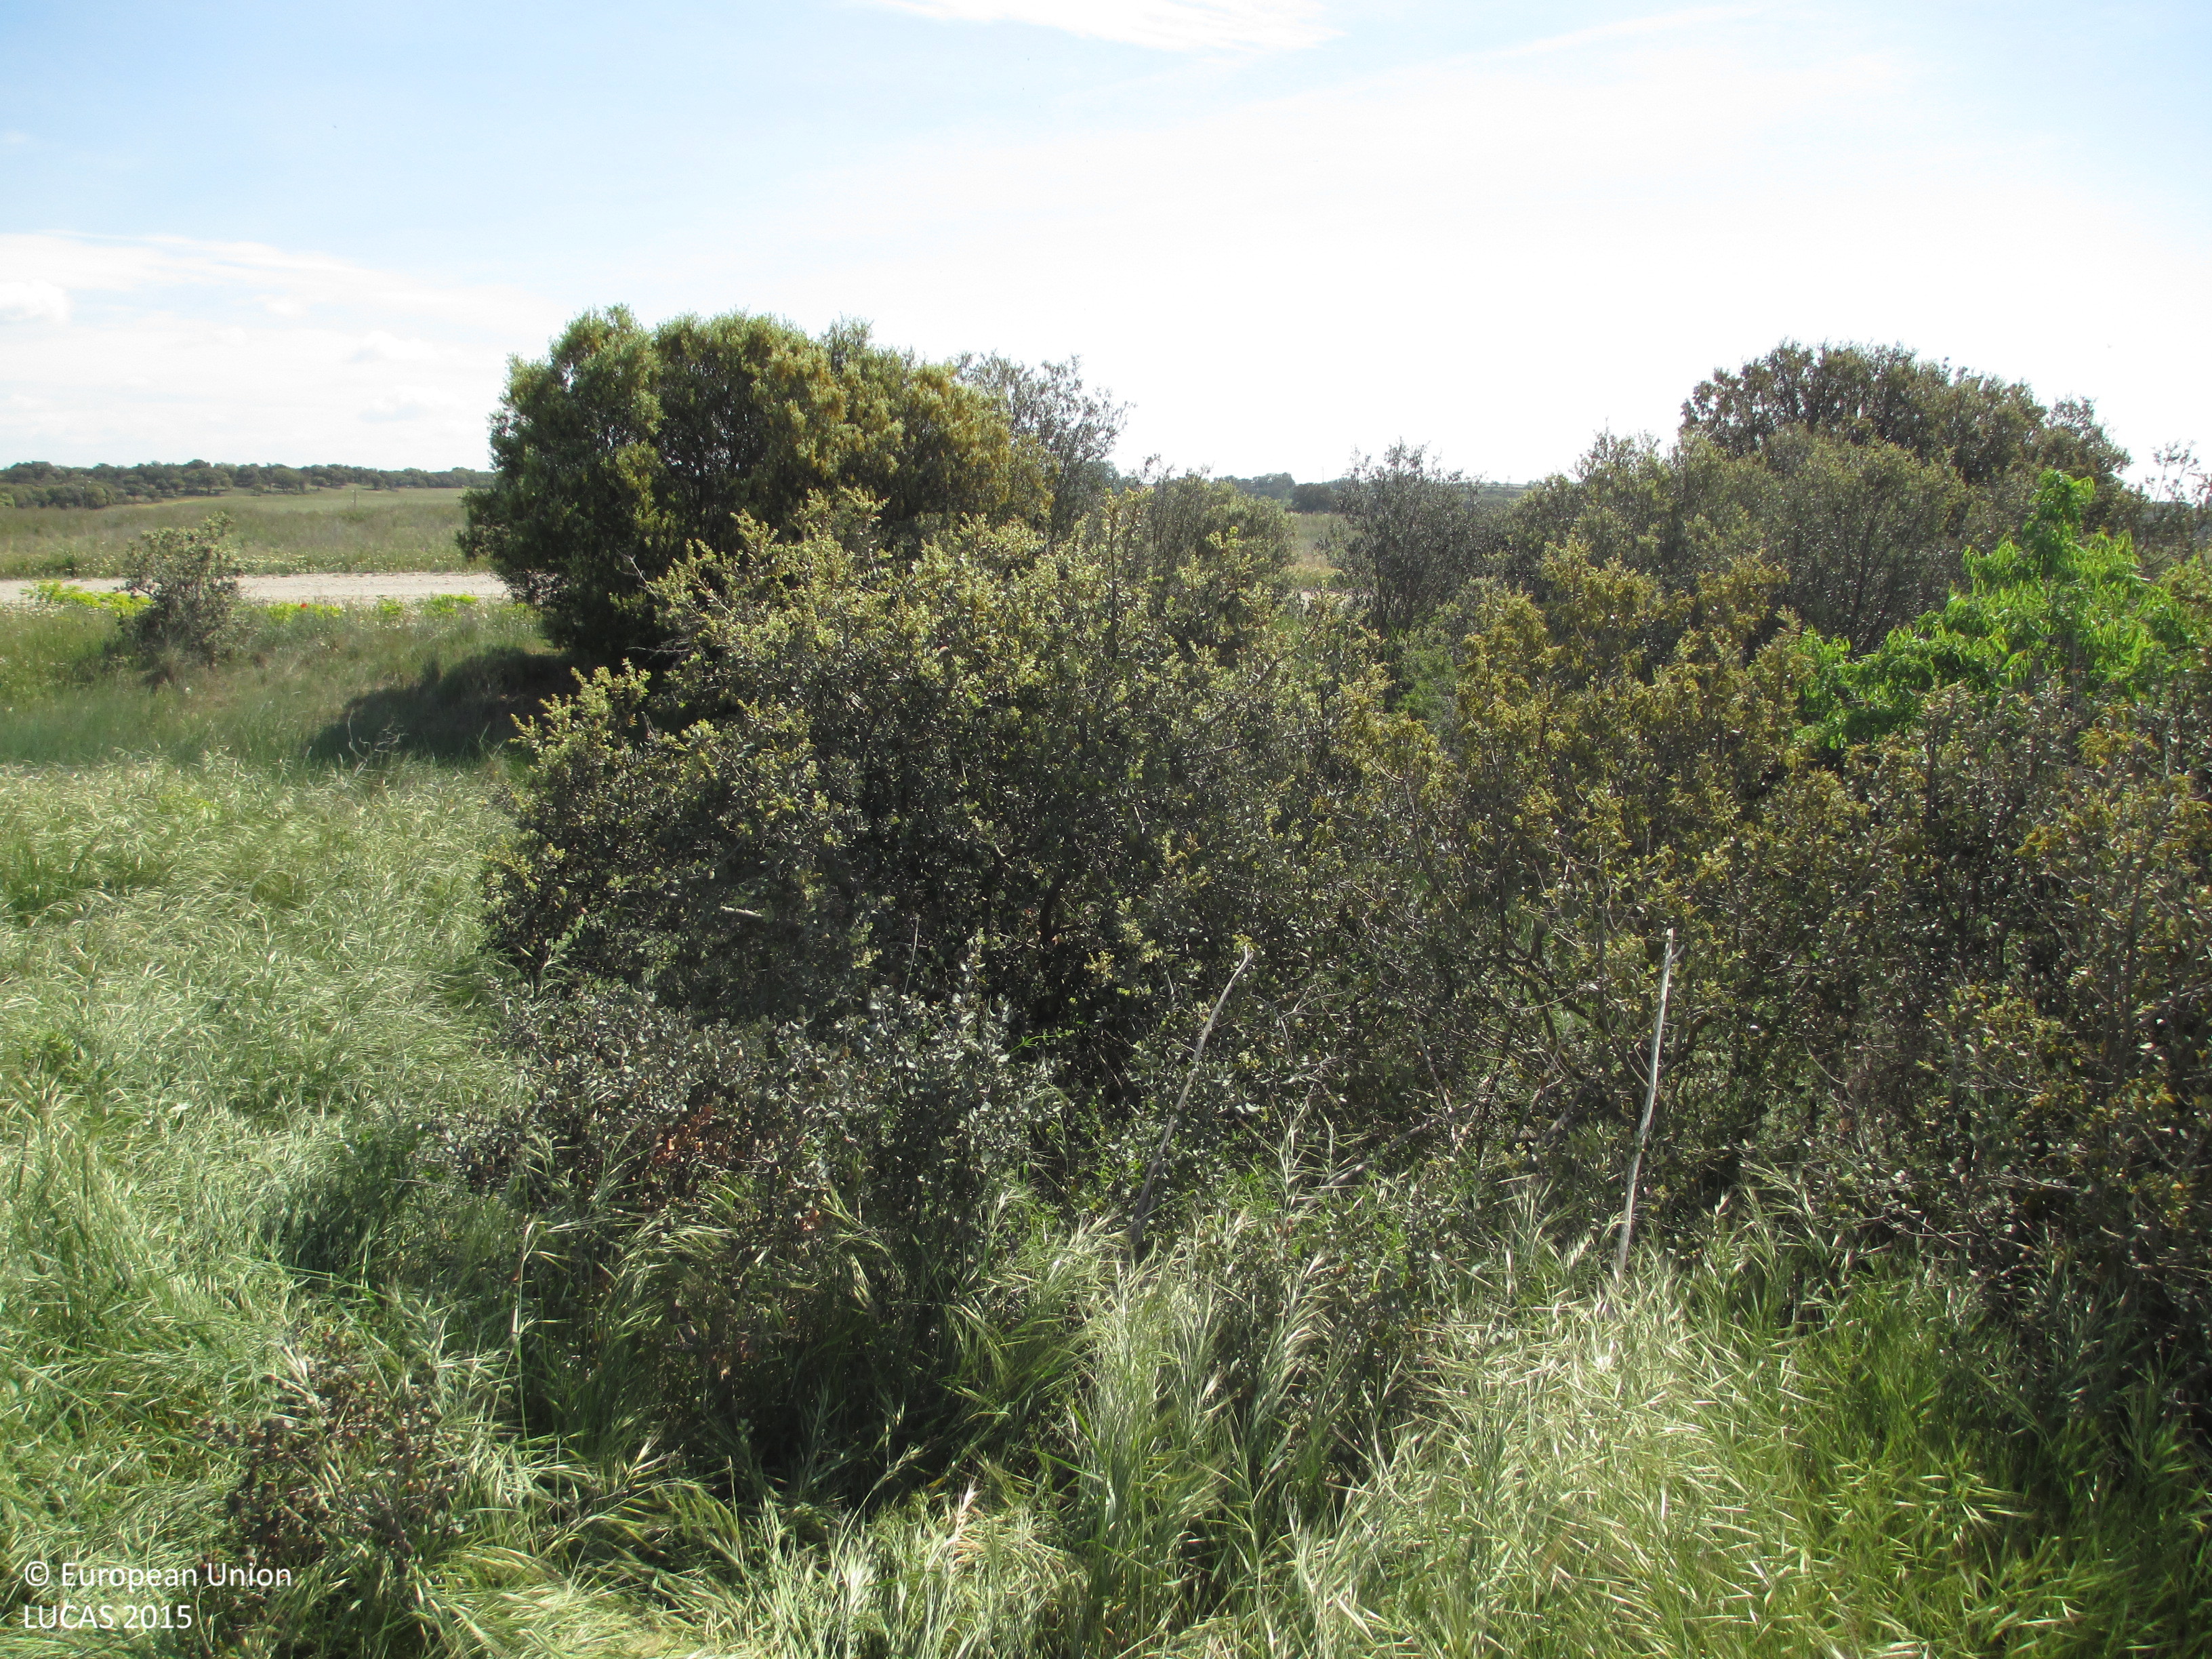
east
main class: Cropland
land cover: Common wheat
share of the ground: > 75 %
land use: Agriculture (excluding fallow land and kitchen gardens)
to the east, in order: Common wheat; Grassland with sparse tree/shrub cover; Tracks; Grassland without tree/shrub cover; Barley
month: April
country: ES
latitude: 42.0931
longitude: -0.4566
